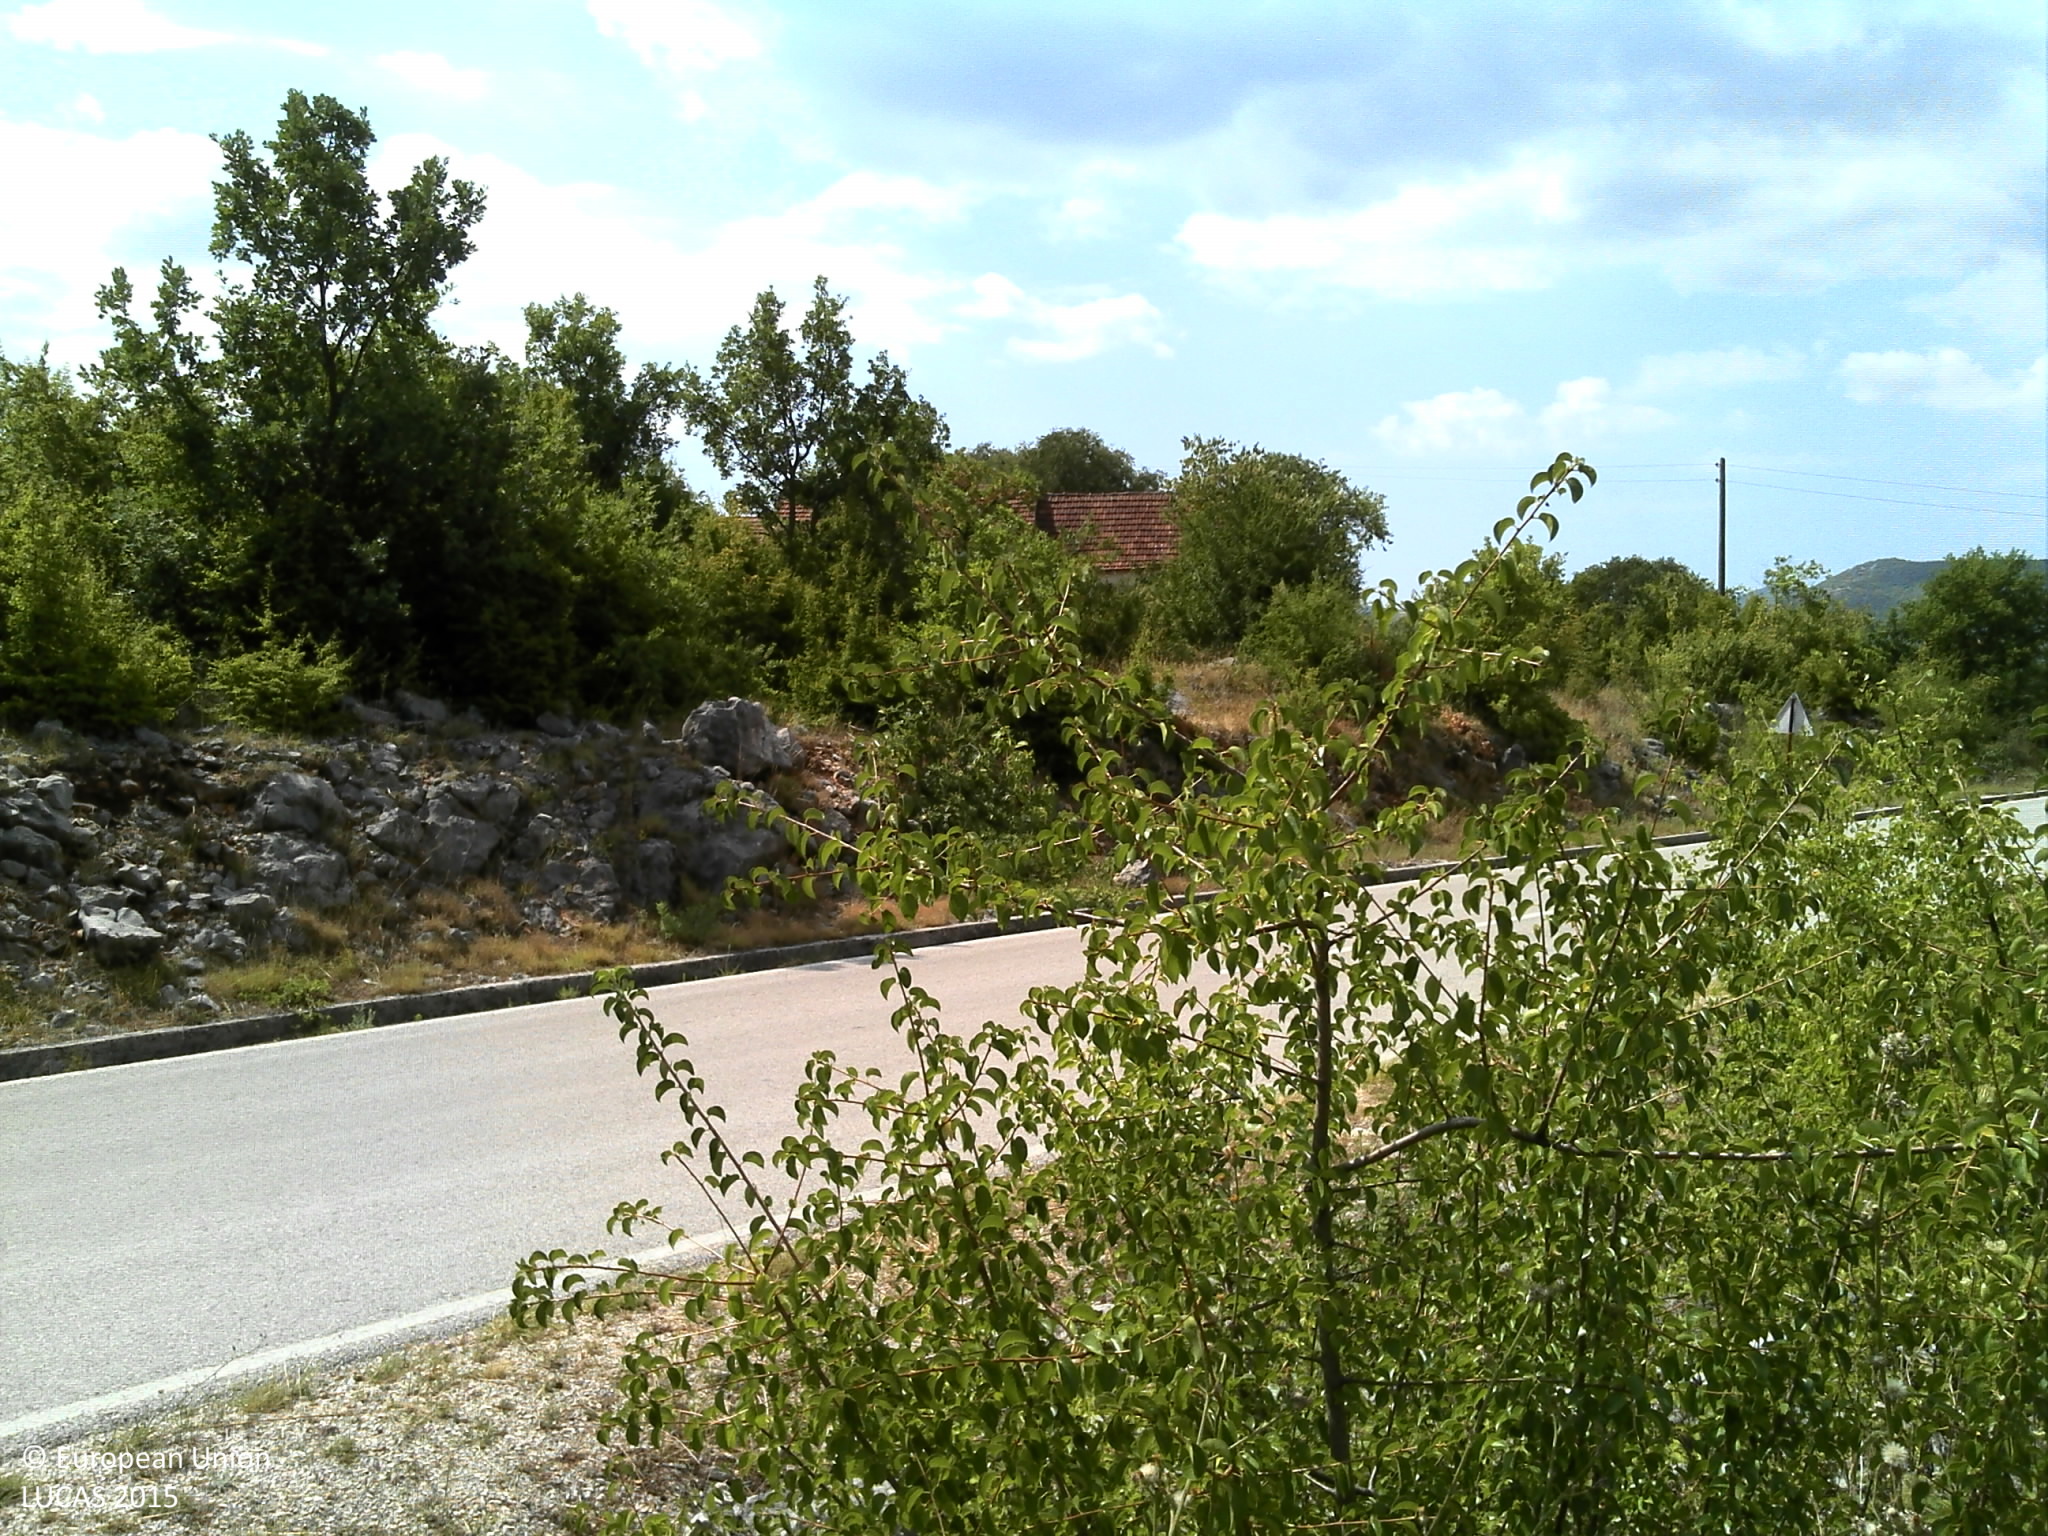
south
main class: Shrubland
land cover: Shrubland with sparse tree cover
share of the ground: 25 - 50 %
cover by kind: herbaceous plants 50 %, shrubs 20 %, unconsolidated bare surface 15 %, consolidated bare surface 10 %, broadleaved forest trees 5 %
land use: Semi-natural and natural areas not in use
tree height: < 5 m
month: July
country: HR
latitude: 43.6974
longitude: 16.1579
